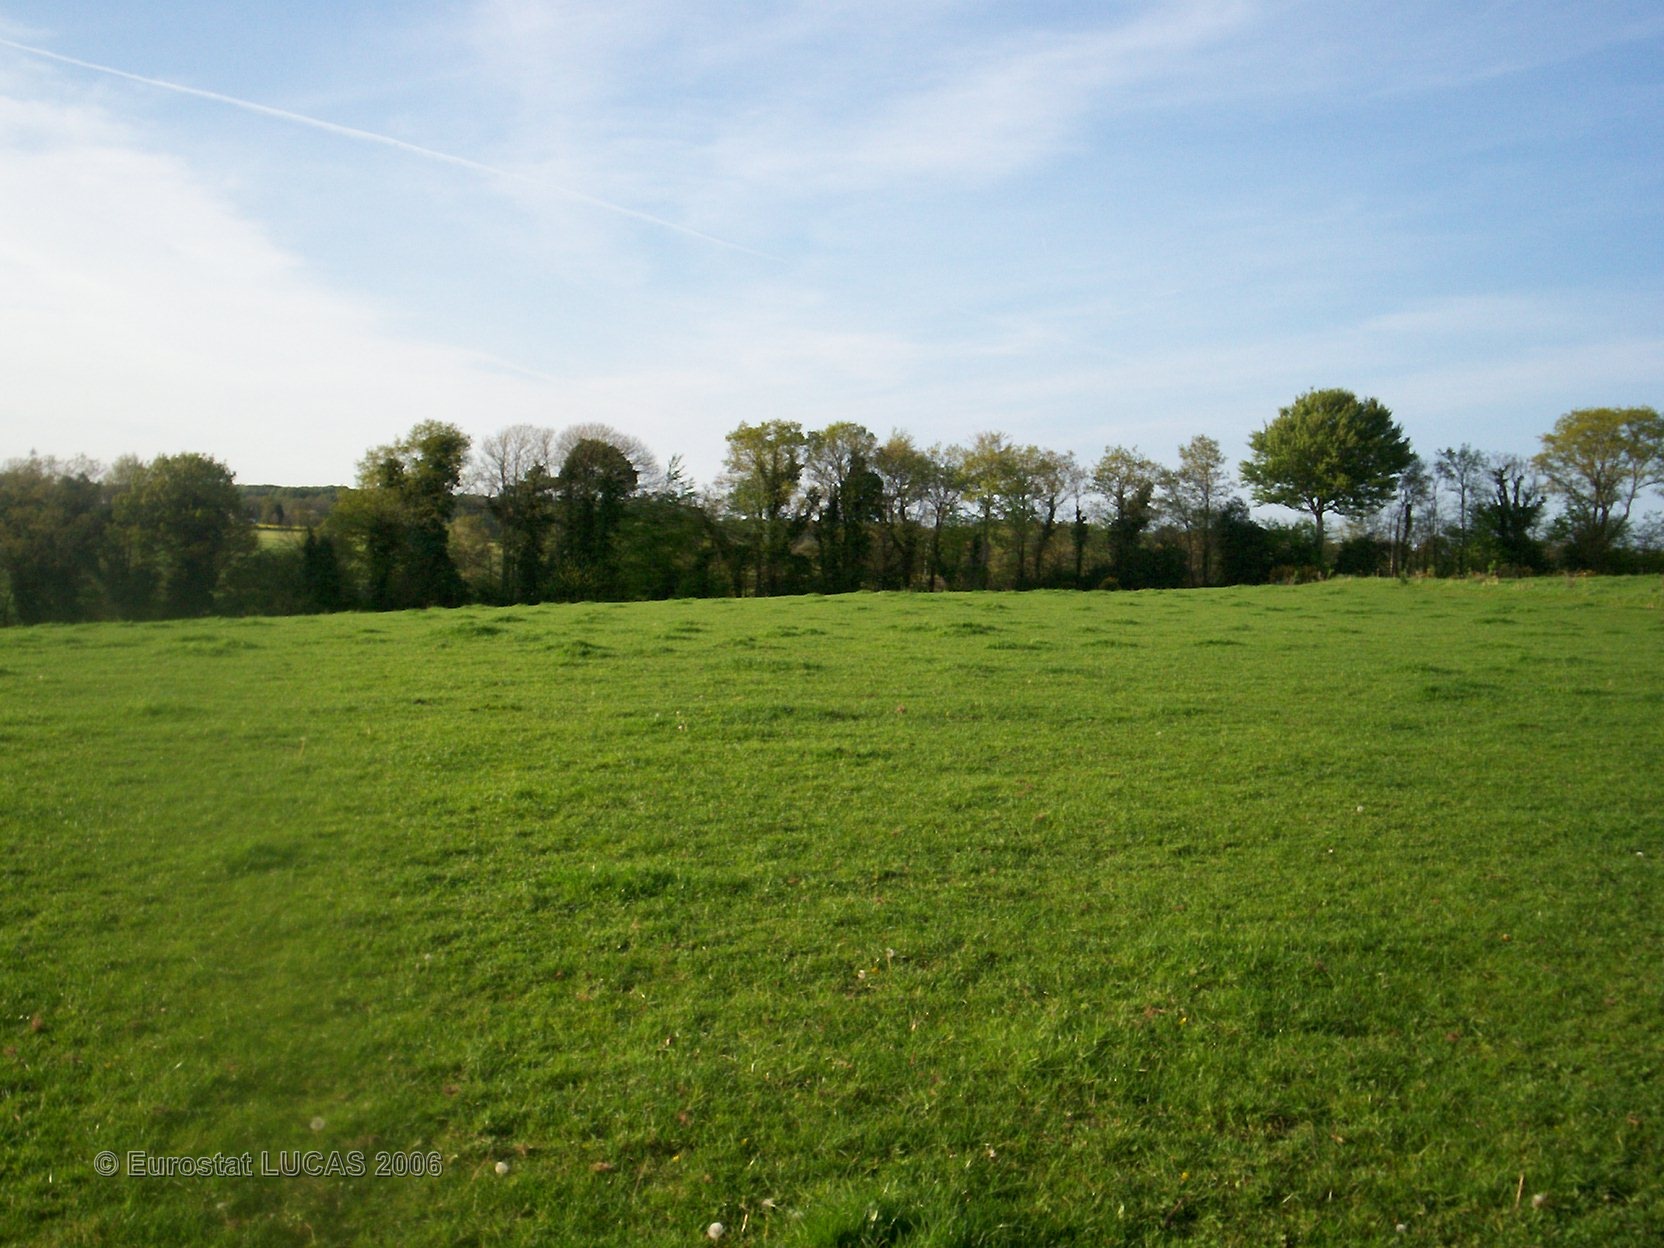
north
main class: Grassland
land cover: Grassland without tree/shrub cover
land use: Agriculture (excluding fallow land and kitchen gardens)
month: May
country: FR
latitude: 47.9945
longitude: -2.8635
